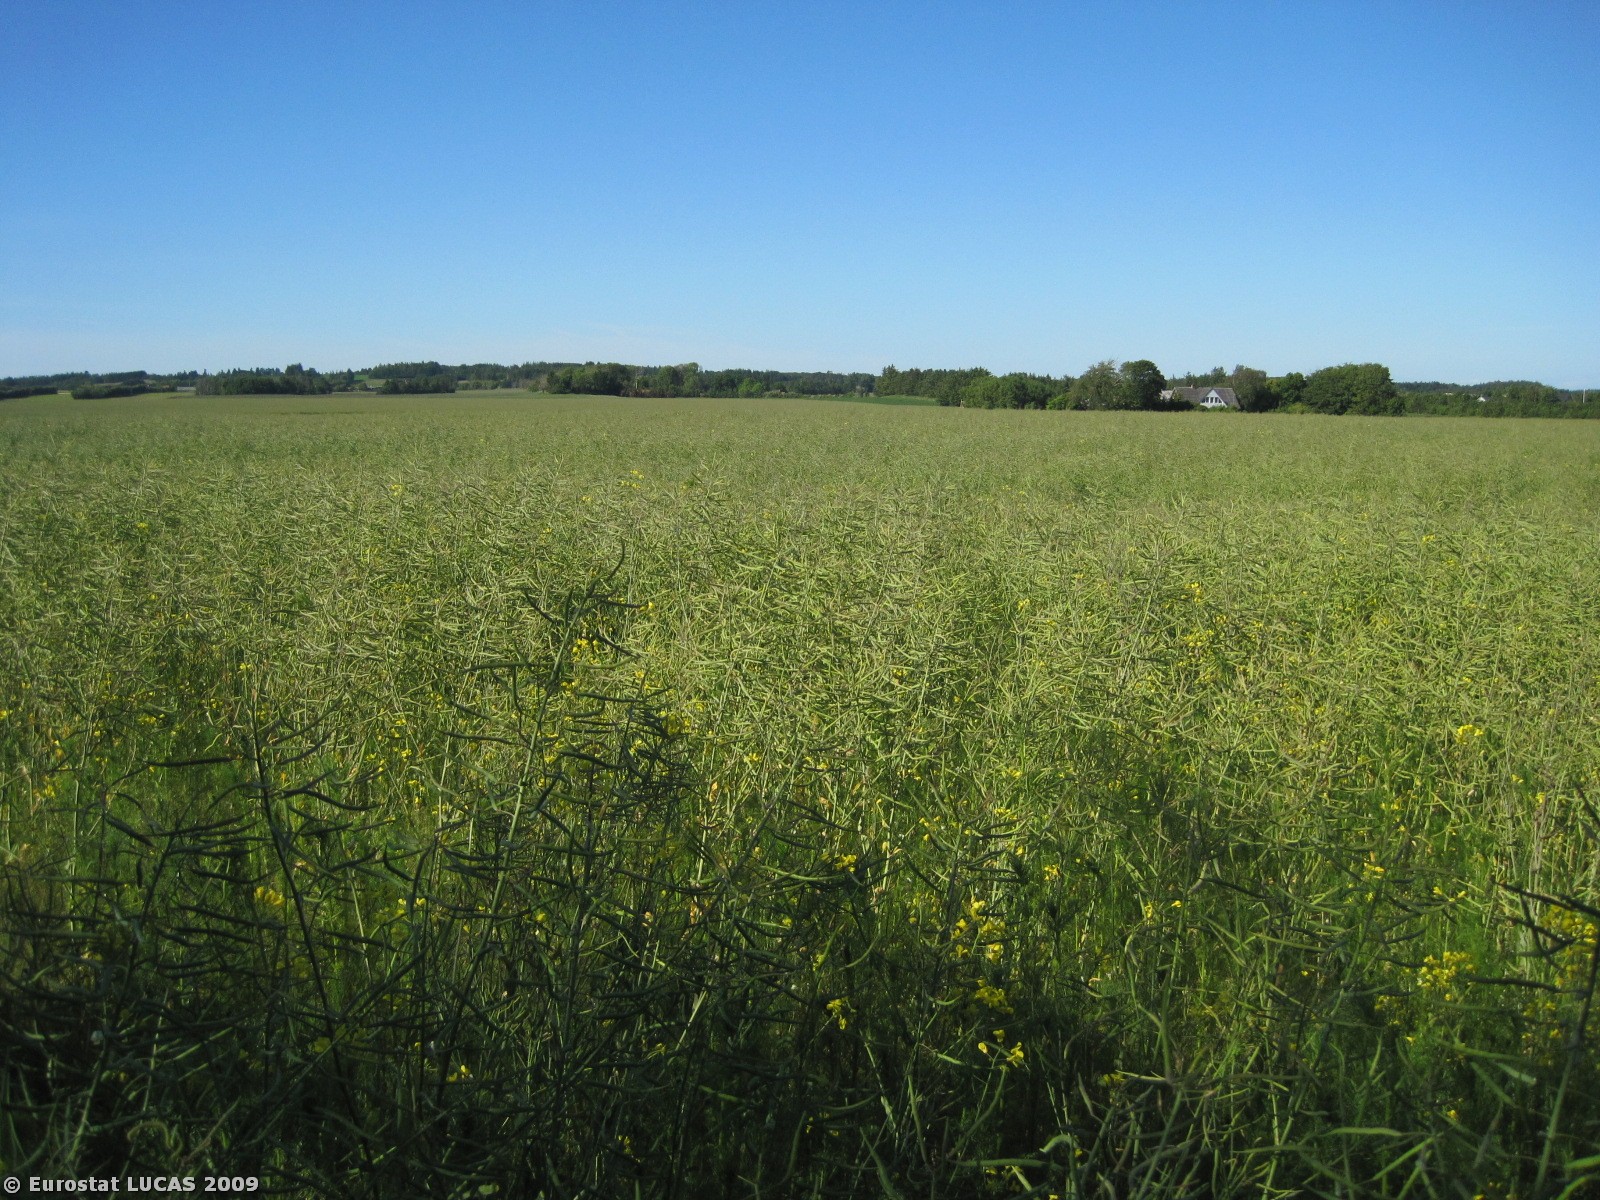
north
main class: Woodland
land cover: Broadleaved woodland
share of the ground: > 75 %
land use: Agriculture (excluding fallow land and kitchen gardens)
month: June
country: DK
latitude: 57.4821
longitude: 10.0500
